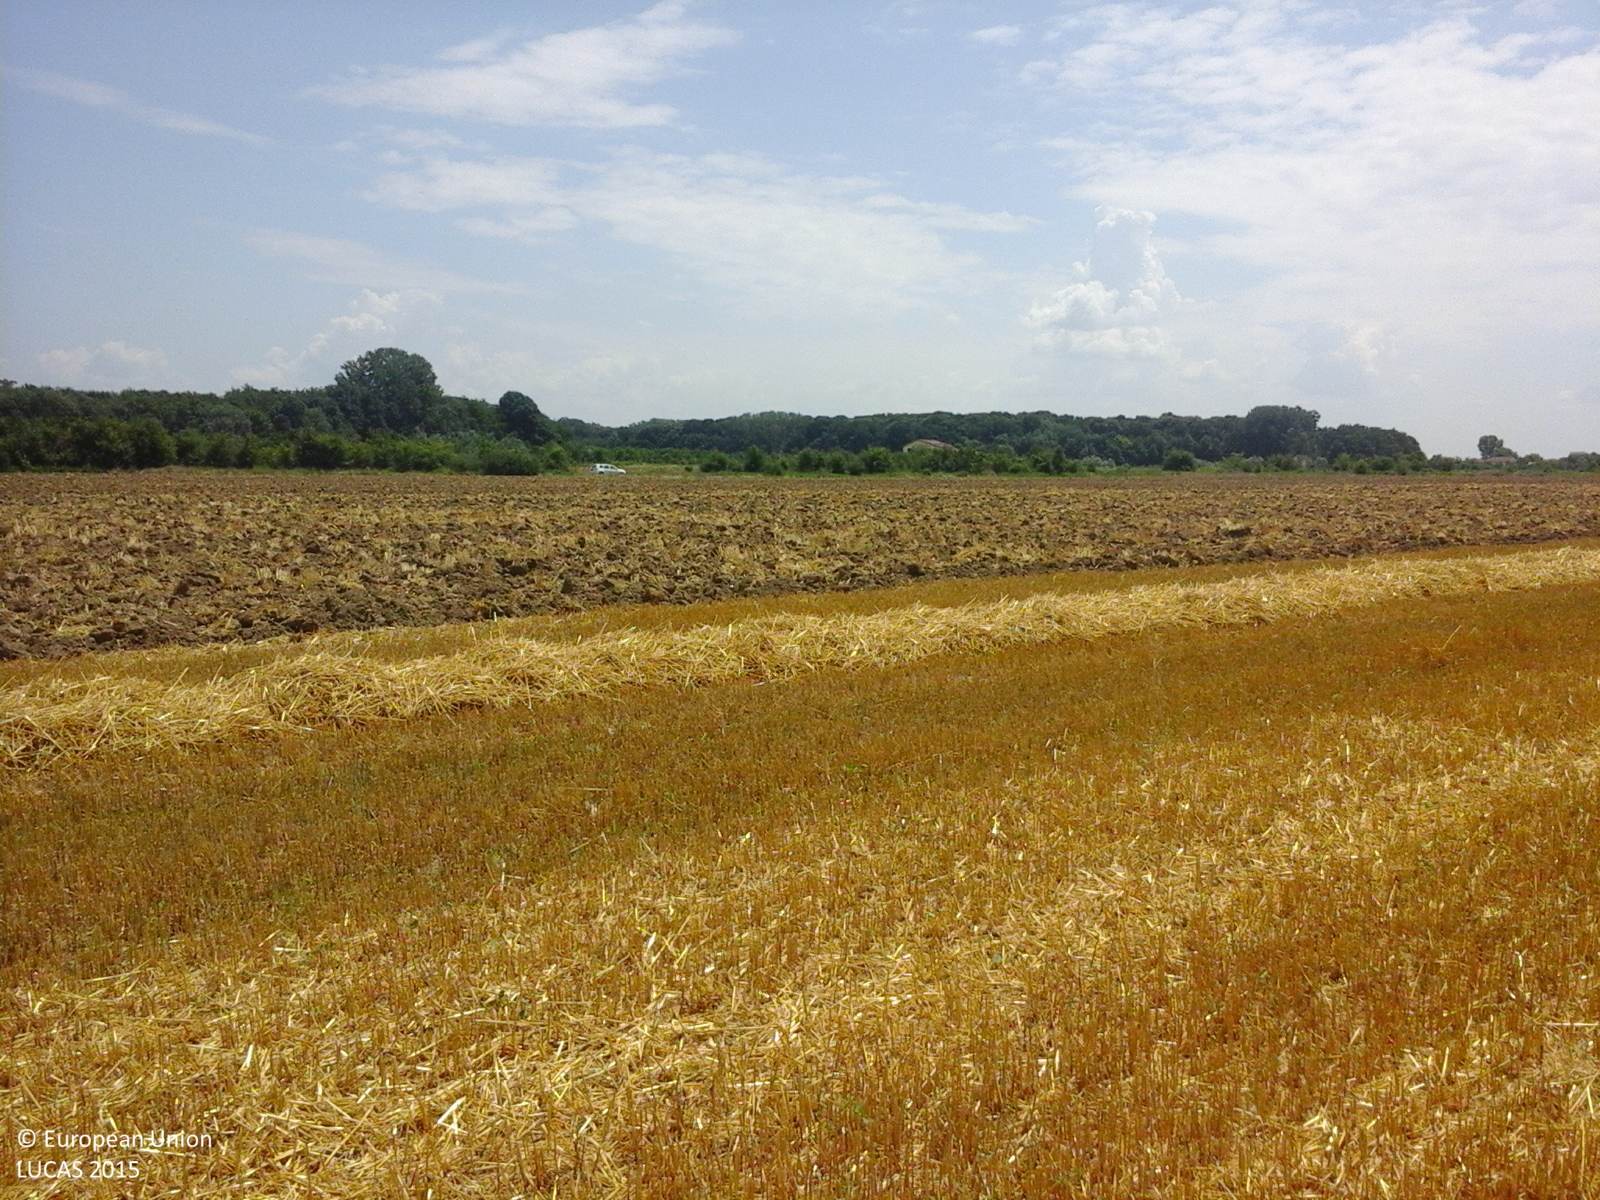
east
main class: Cropland
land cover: Barley
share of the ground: > 75 %
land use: Agriculture (excluding fallow land and kitchen gardens)
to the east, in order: Barley; Other bare soil; Grass margins; Shrubland with sparse tree cover; Tracks; Shrubland with sparse tree cover; Tracks; Other bare soil
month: June
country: RO
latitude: 44.3675
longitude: 25.8726
